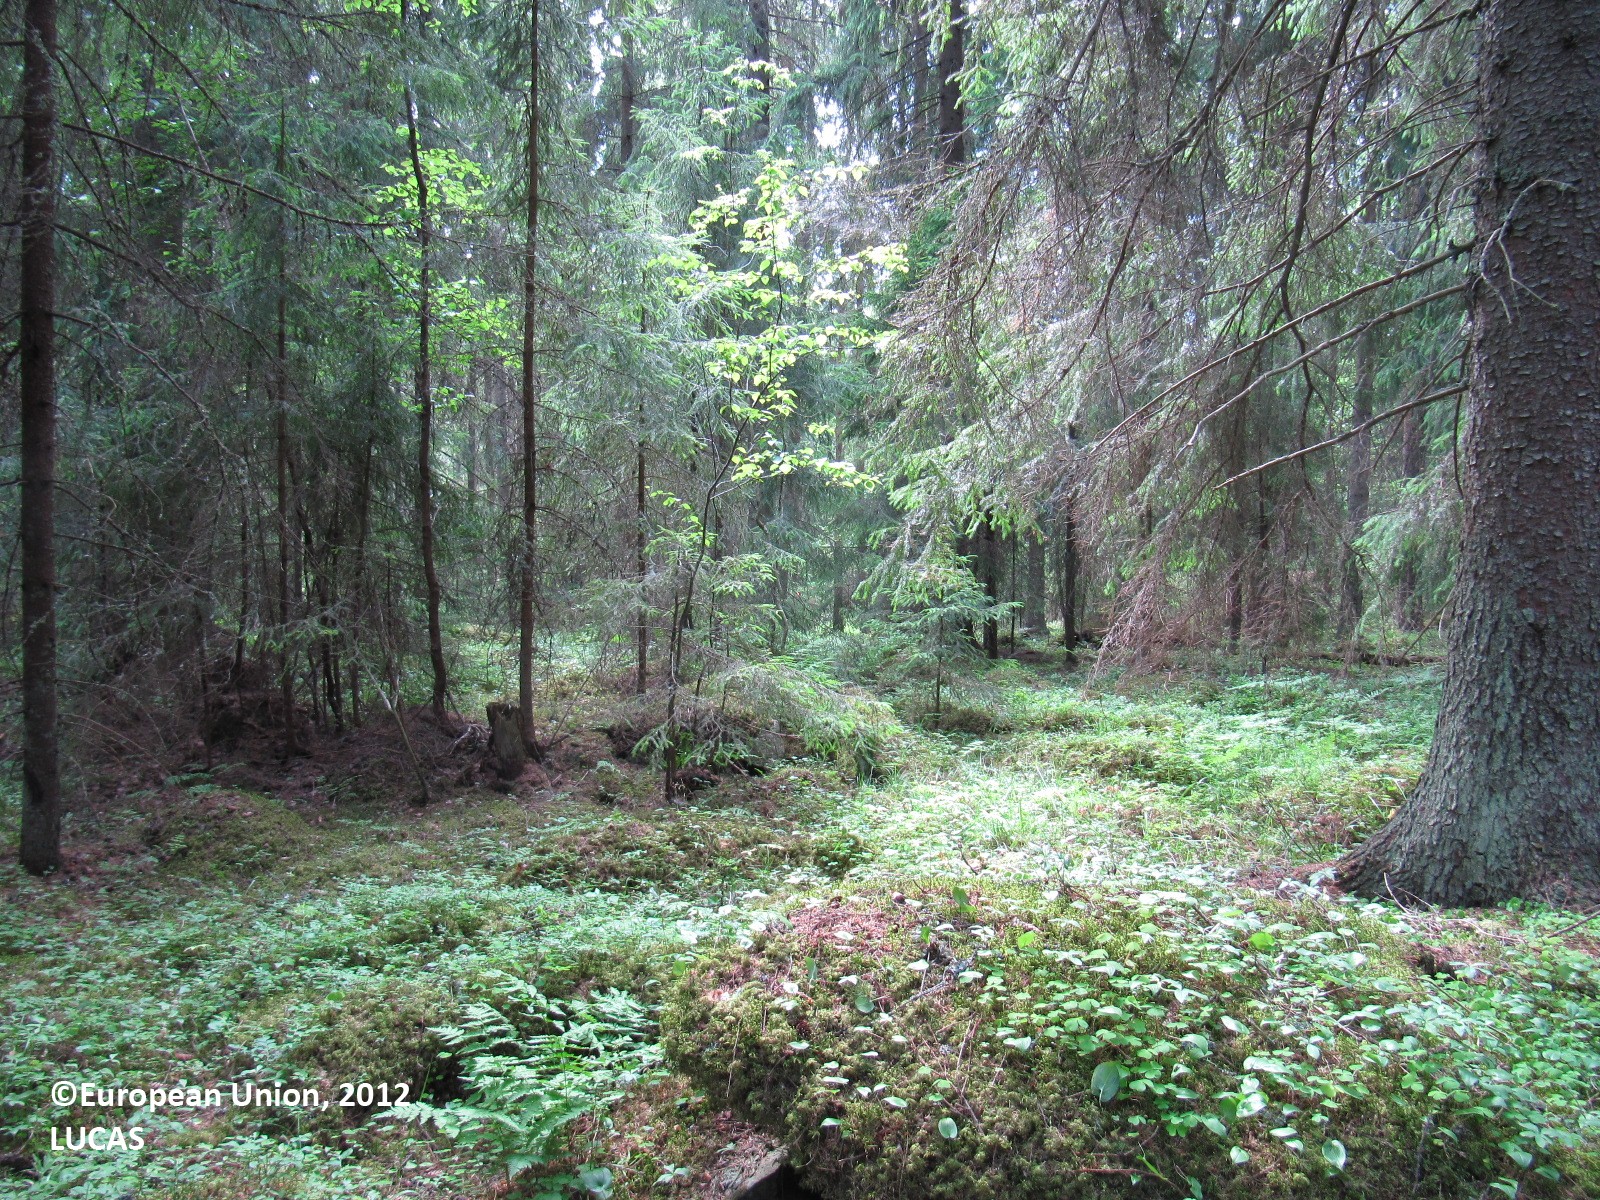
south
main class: Woodland
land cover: Spruce dominated coniferous woodland
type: boreal forest
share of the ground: > 75 %
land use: Forestry
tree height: > 5 m
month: July
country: FI
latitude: 61.0149
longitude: 23.4574
